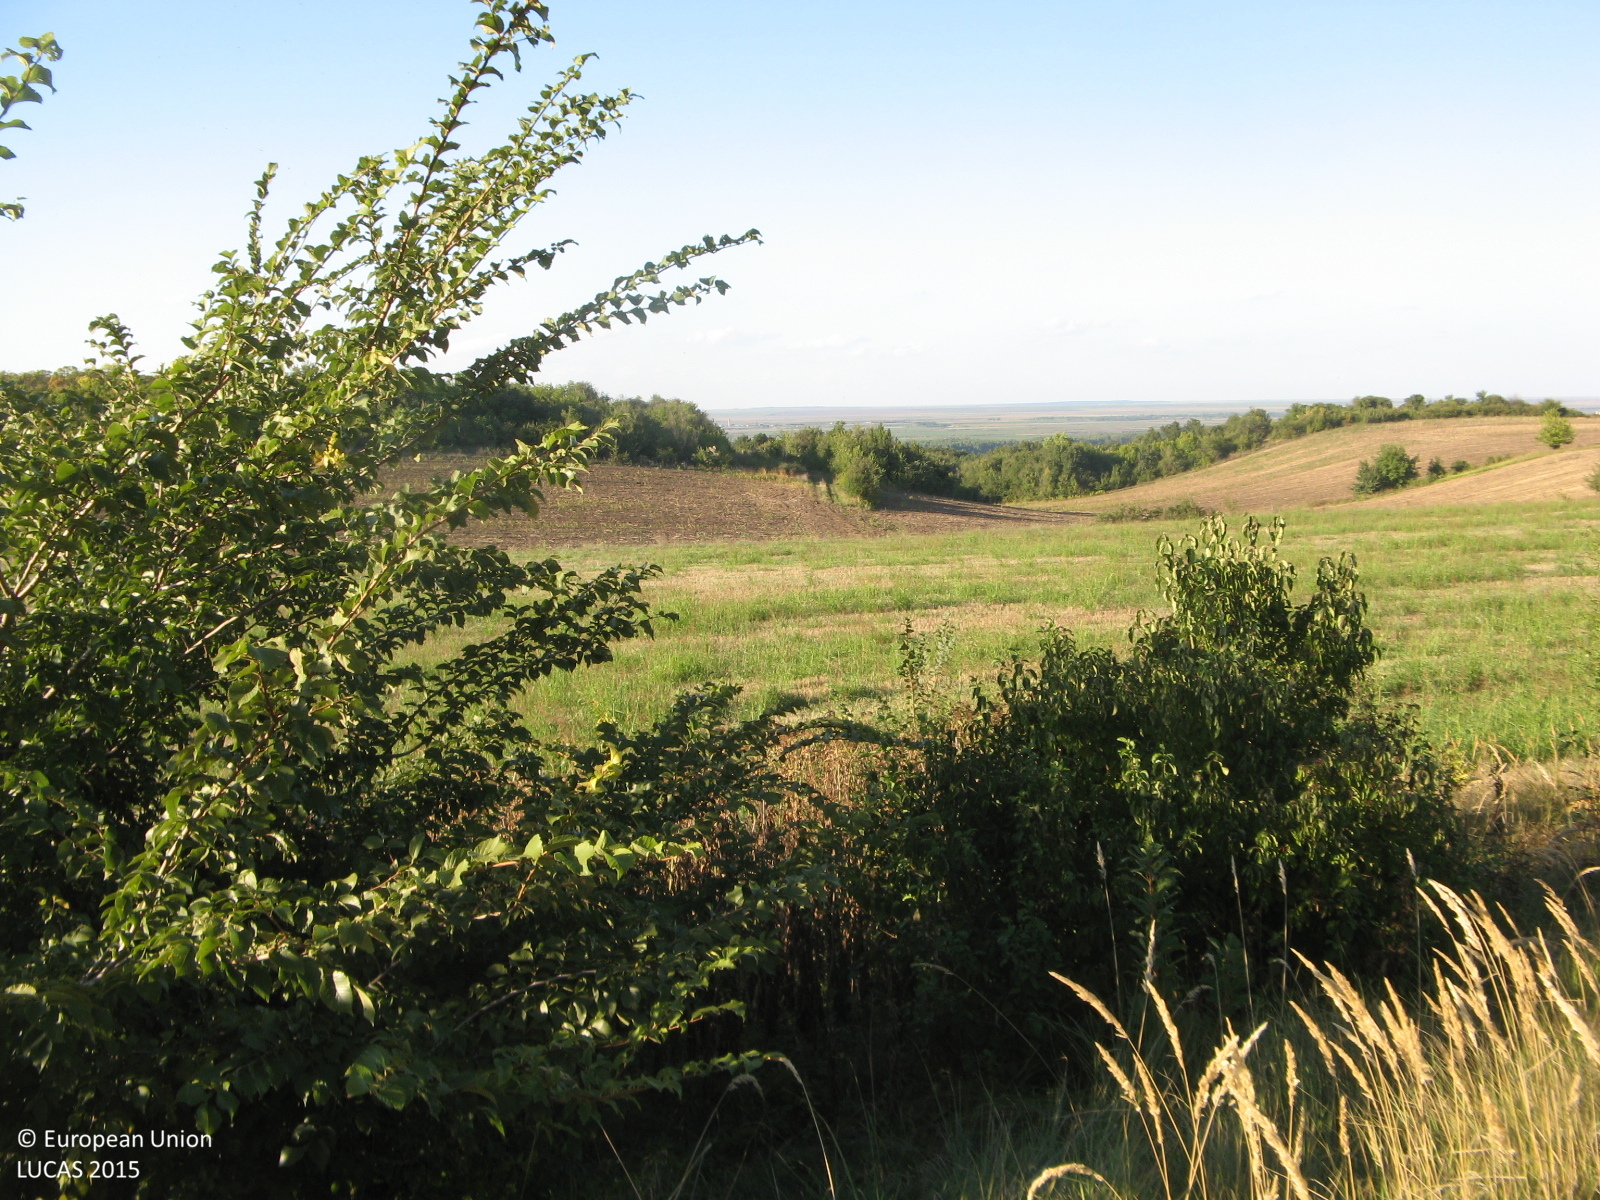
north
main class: Grassland
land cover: Grassland with sparse tree/shrub cover
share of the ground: > 75 %
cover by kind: herbaceous plants 90 %, broadleaved forest trees 5 %, shrubs 5 %
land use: Semi-natural and natural areas not in use
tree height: < 5 m
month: September
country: BG
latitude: 43.6096
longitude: 25.4324
